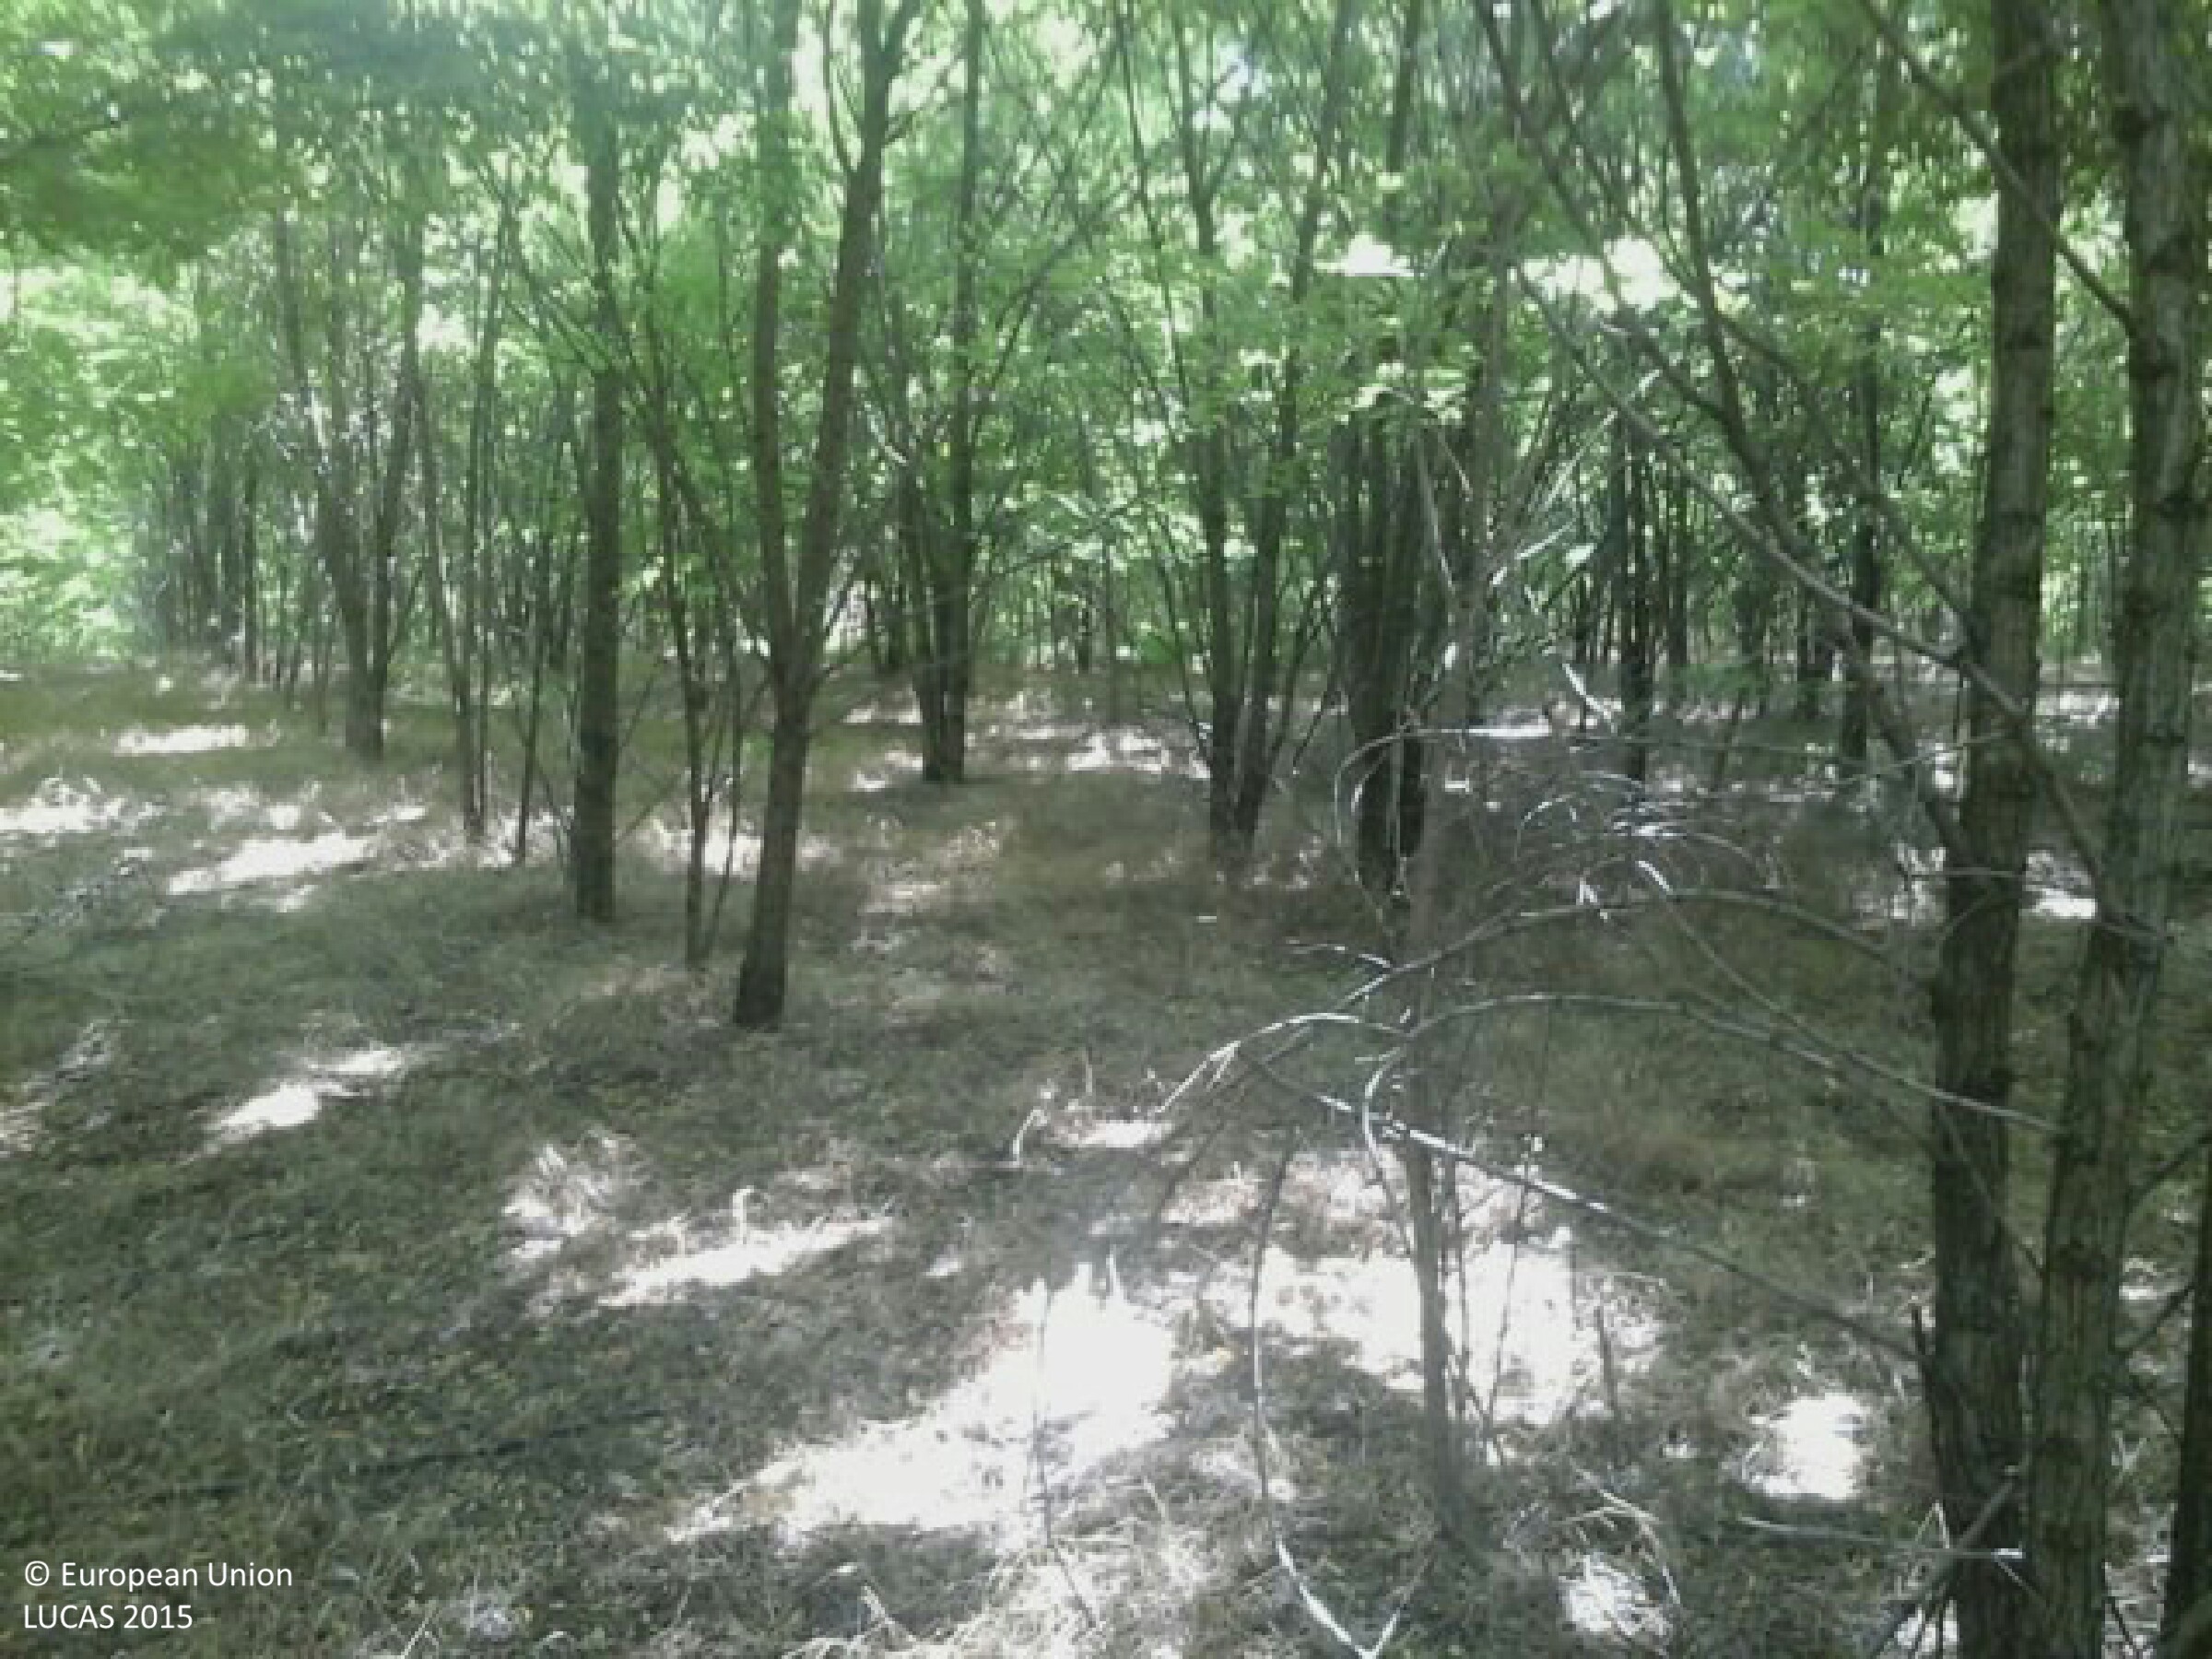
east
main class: Woodland
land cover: Broadleaved woodland
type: mesophytic deciduous forest
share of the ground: > 75 %
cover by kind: broadleaved forest trees 75 %, herbaceous plants 25 %
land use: Forestry
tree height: > 5 m
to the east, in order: Broadleaved woodland; Grassland without tree/shrub cover; Tracks; Grassland without tree/shrub cover; Broadleaved woodland
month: July
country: HU
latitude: 46.7539
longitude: 18.9556
